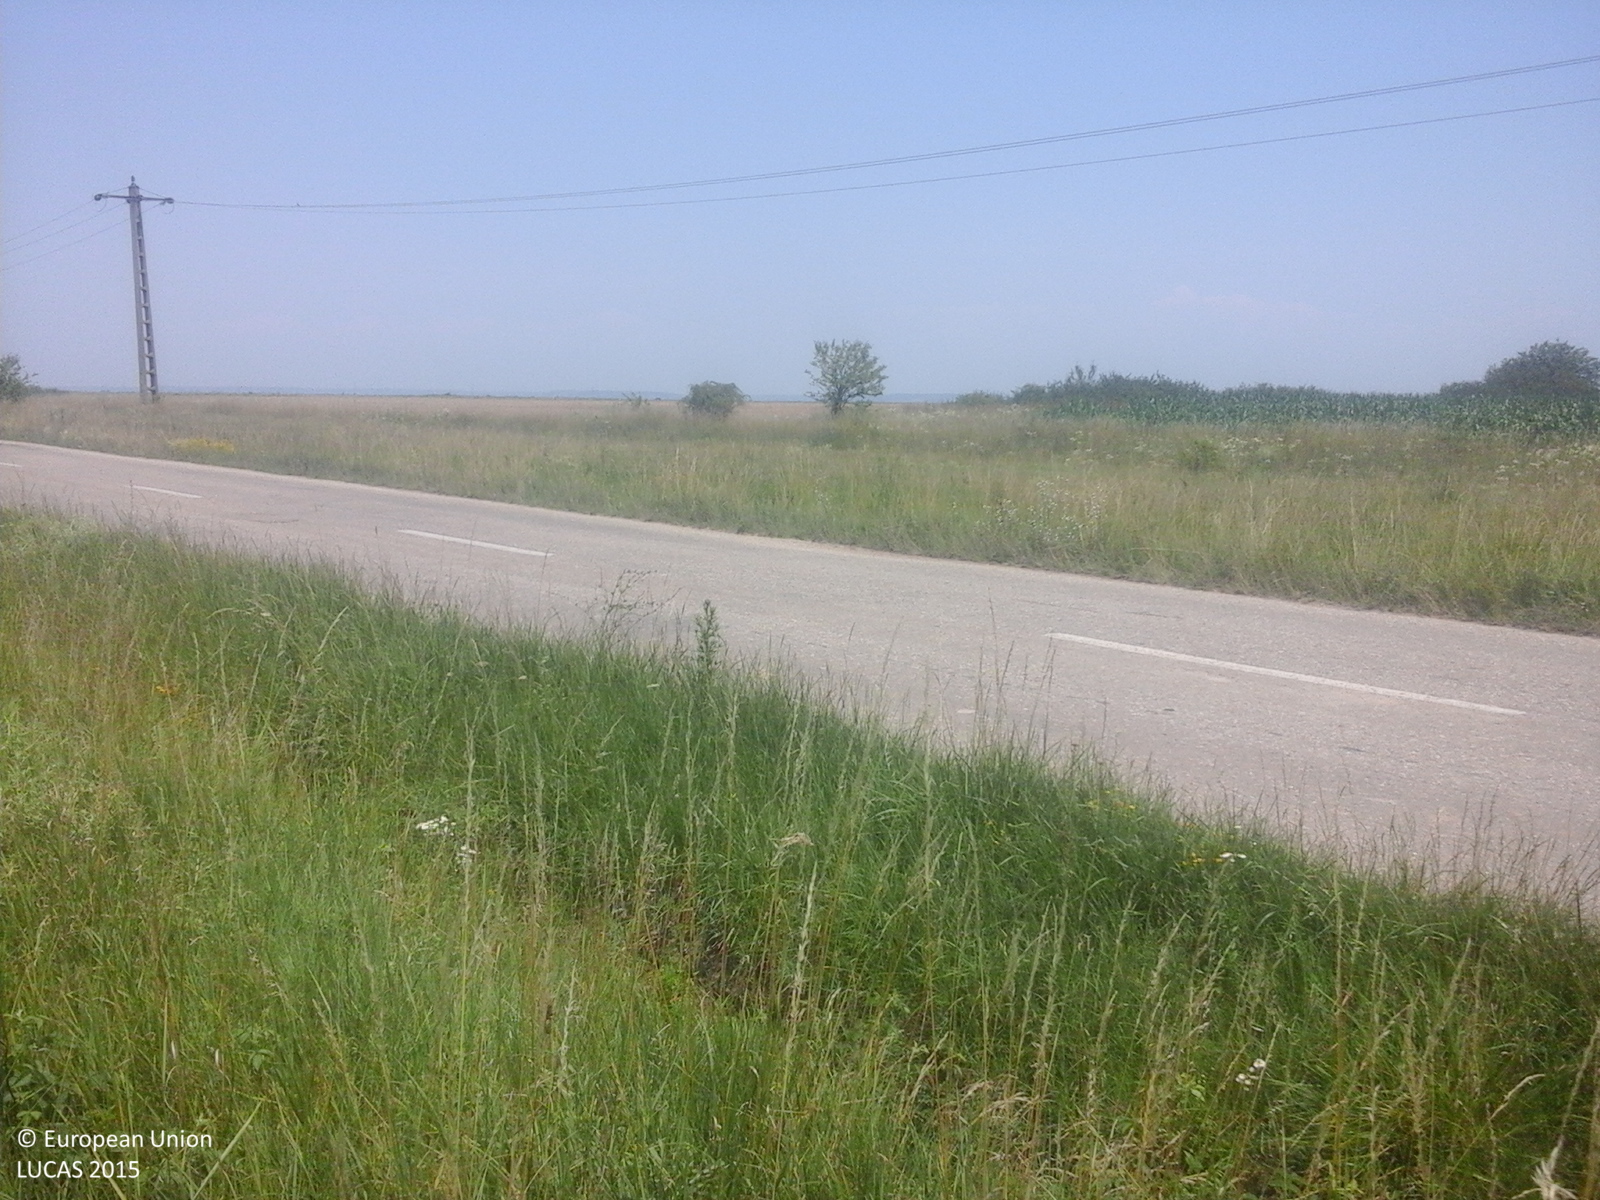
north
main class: Grassland
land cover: Grassland without tree/shrub cover
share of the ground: > 75 %
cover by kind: herbaceous plants 100 %
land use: Agriculture (excluding fallow land and kitchen gardens)
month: July
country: RO
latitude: 44.6982
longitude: 25.0124
